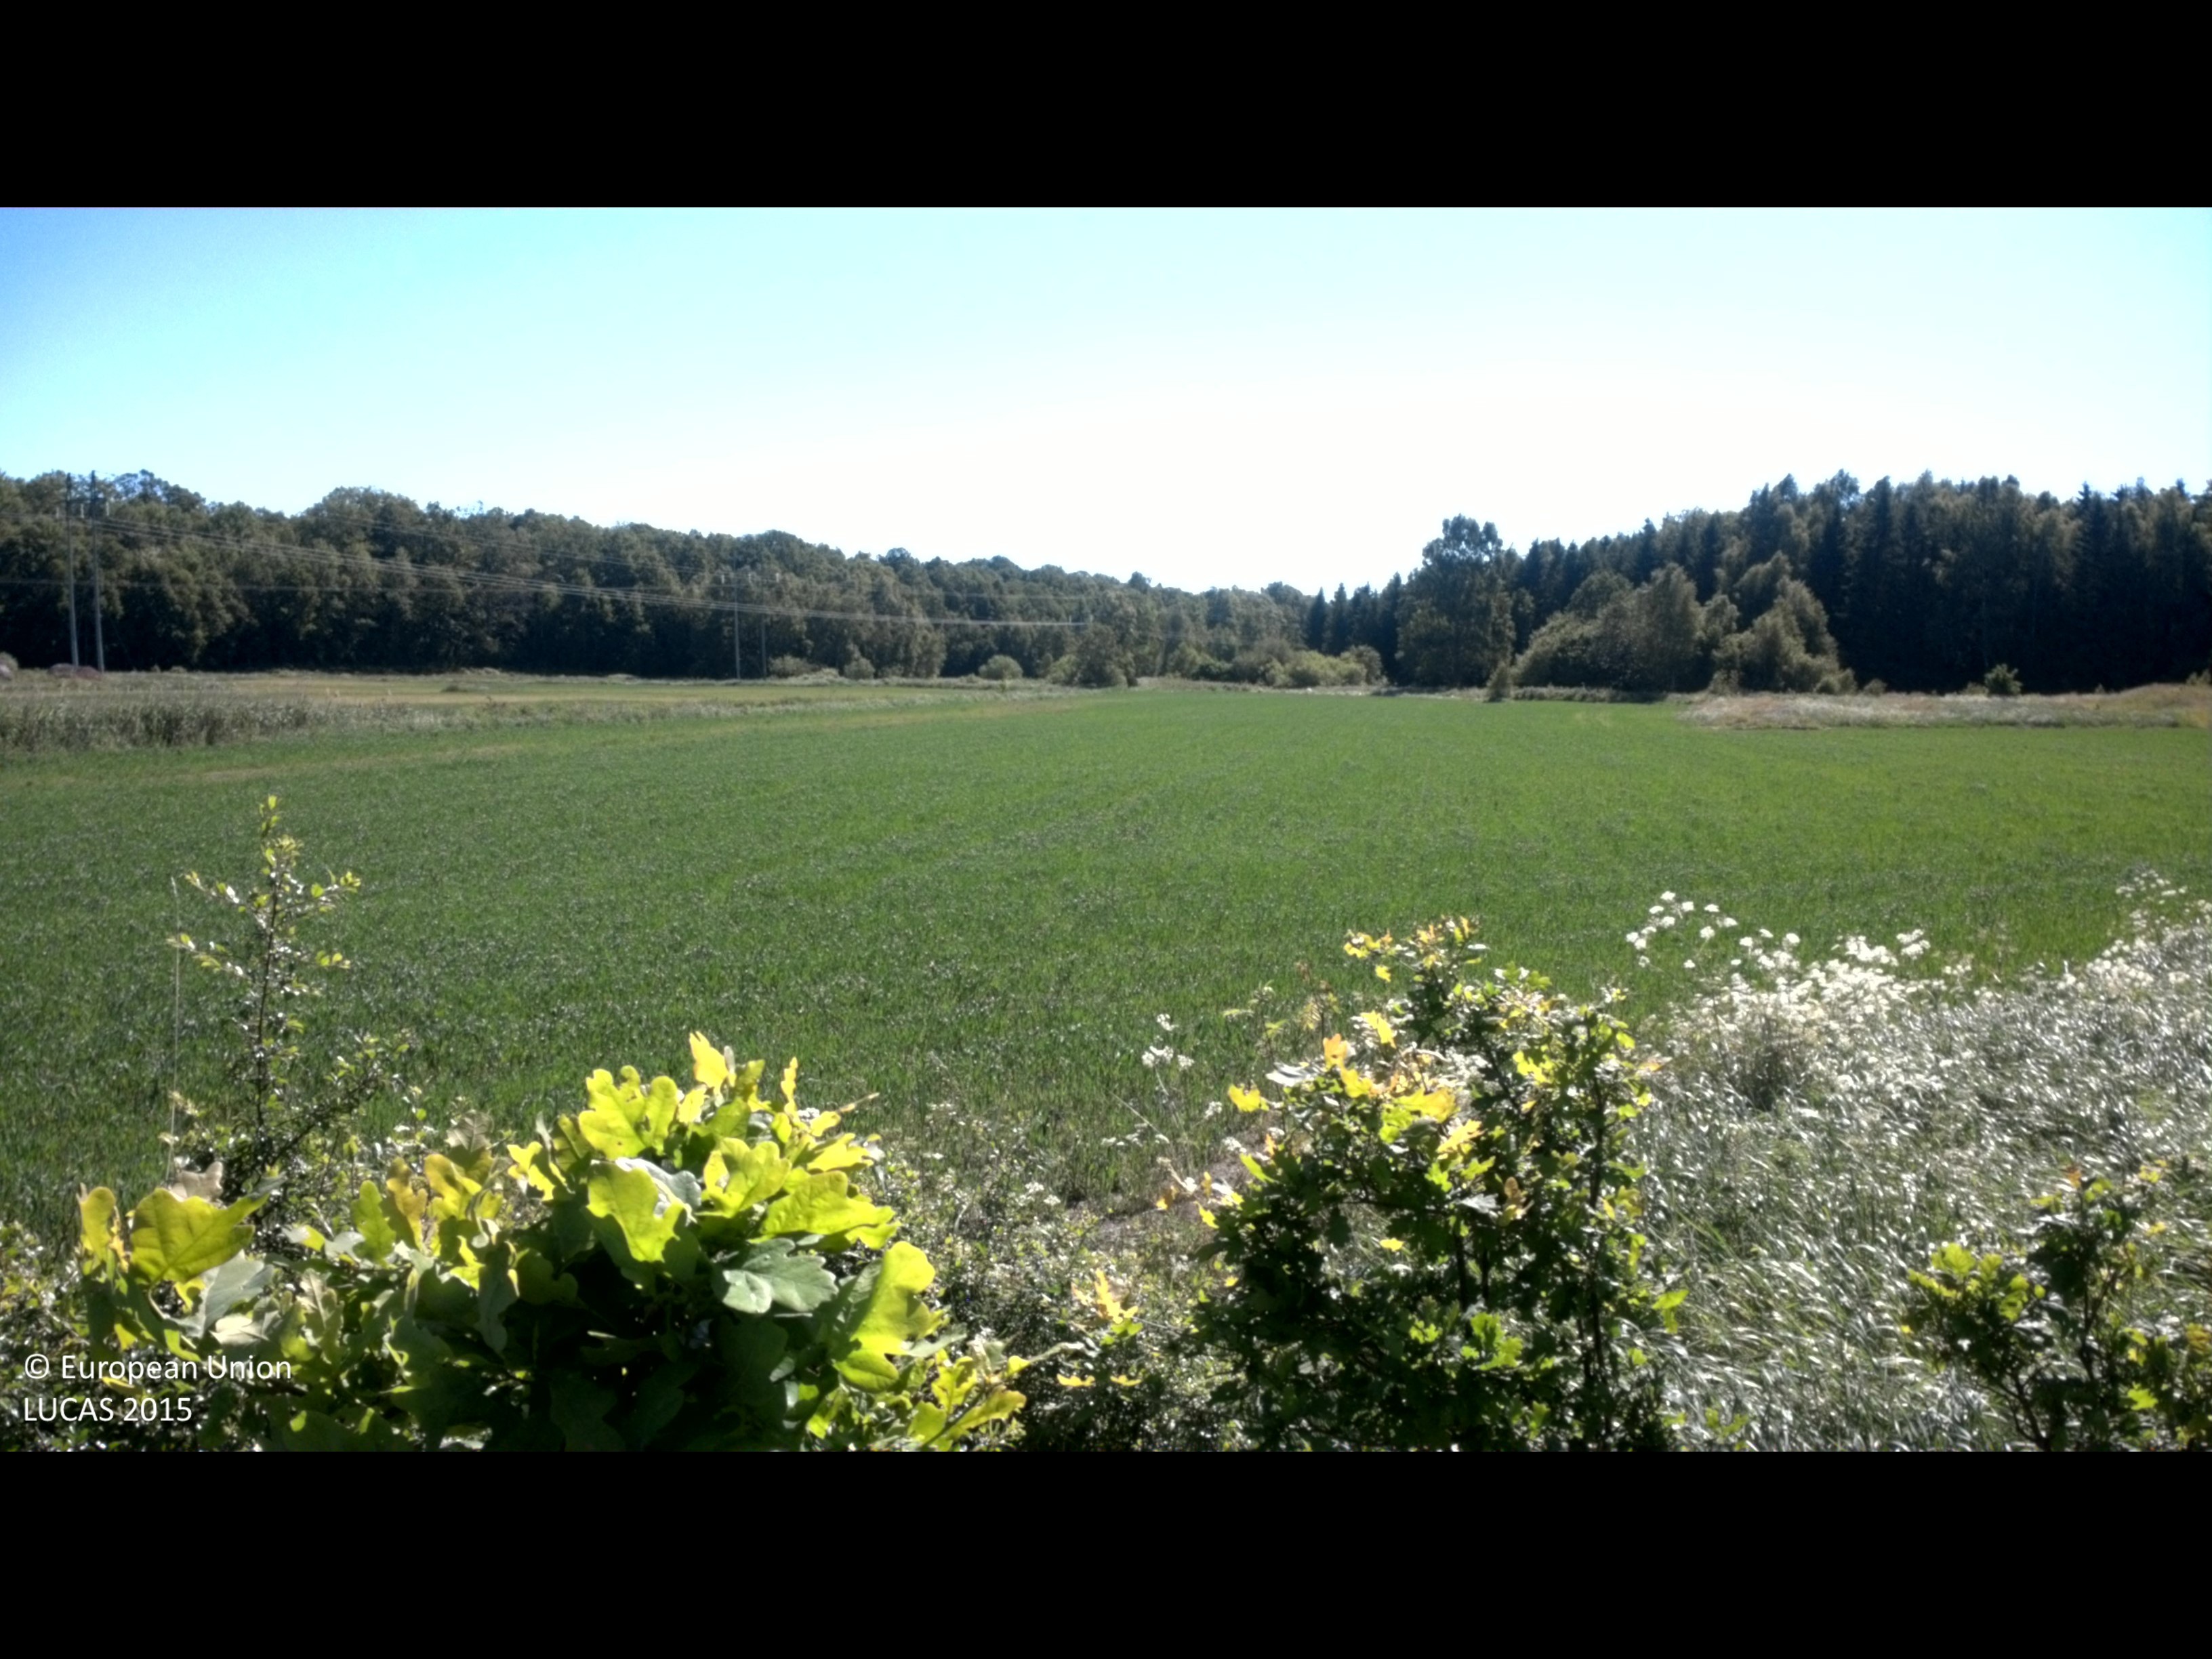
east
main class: Woodland
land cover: Broadleaved woodland
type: hemiboreal forest and nemoral coniferous forest and mixed broadleaved-coniferous forest
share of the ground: 50 - 75 %
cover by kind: broadleaved forest trees 75 %, herbaceous plants 20 %, shrubs 5 %
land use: Forestry
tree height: > 5 m
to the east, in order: Broadleaved woodland; Rye; Grass margins; Ditches and canals; Grass margins; Rye; Spontaneously vegetated surfaces; Ditches and canals
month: June
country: SE
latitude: 57.7308
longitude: 16.6323
